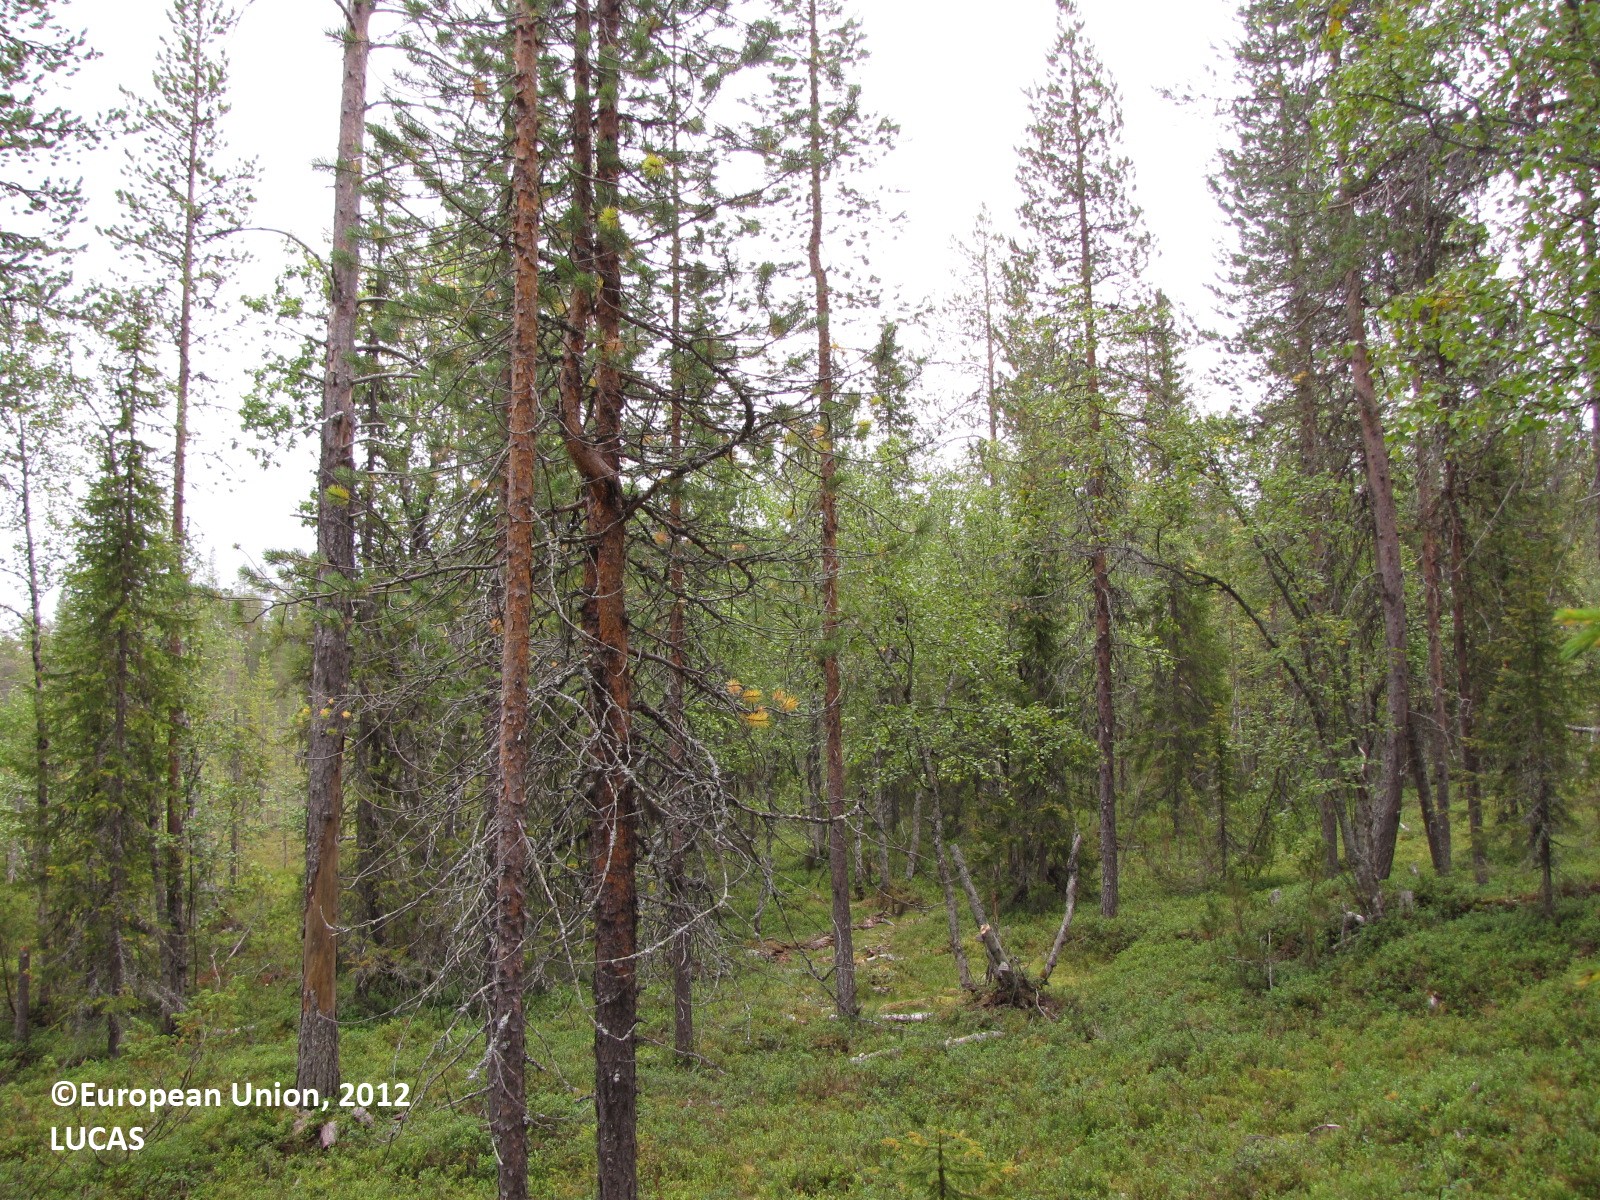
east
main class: Woodland
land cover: Pine dominated mixed woodland
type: boreal forest
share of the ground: 50 - 75 %
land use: Forestry
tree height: > 5 m
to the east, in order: Pine dominated mixed woodland; Ditches and canals; Paved roads, cycling and walking lanes; Pine dominated mixed woodland
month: August
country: FI
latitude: 67.1262
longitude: 25.3363
